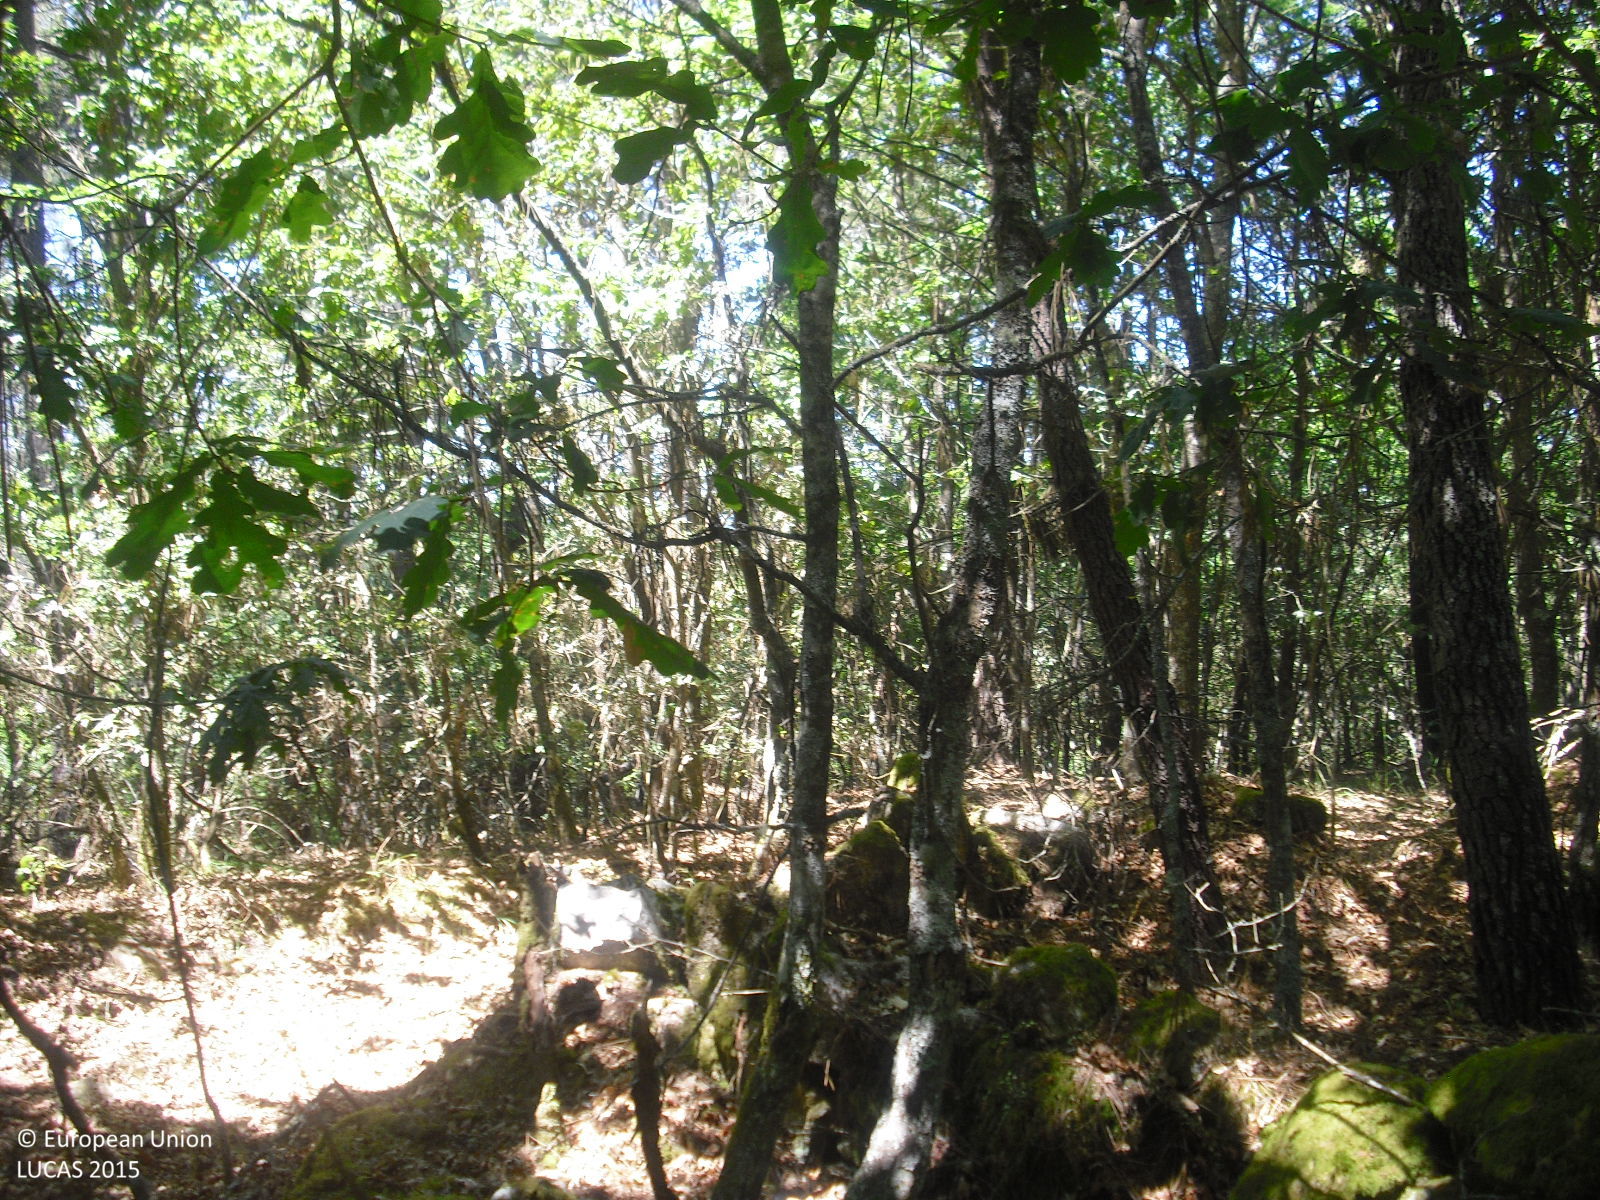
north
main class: Woodland
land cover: Pine dominated mixed woodland
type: hemiboreal forest and nemoral coniferous forest and mixed broadleaved-coniferous forest
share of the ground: > 75 %
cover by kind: broadleaved forest trees 60 %, coniferous forest trees 40 %
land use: Forestry
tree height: > 5 m
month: June
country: ES
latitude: 42.4867
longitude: -7.7781
